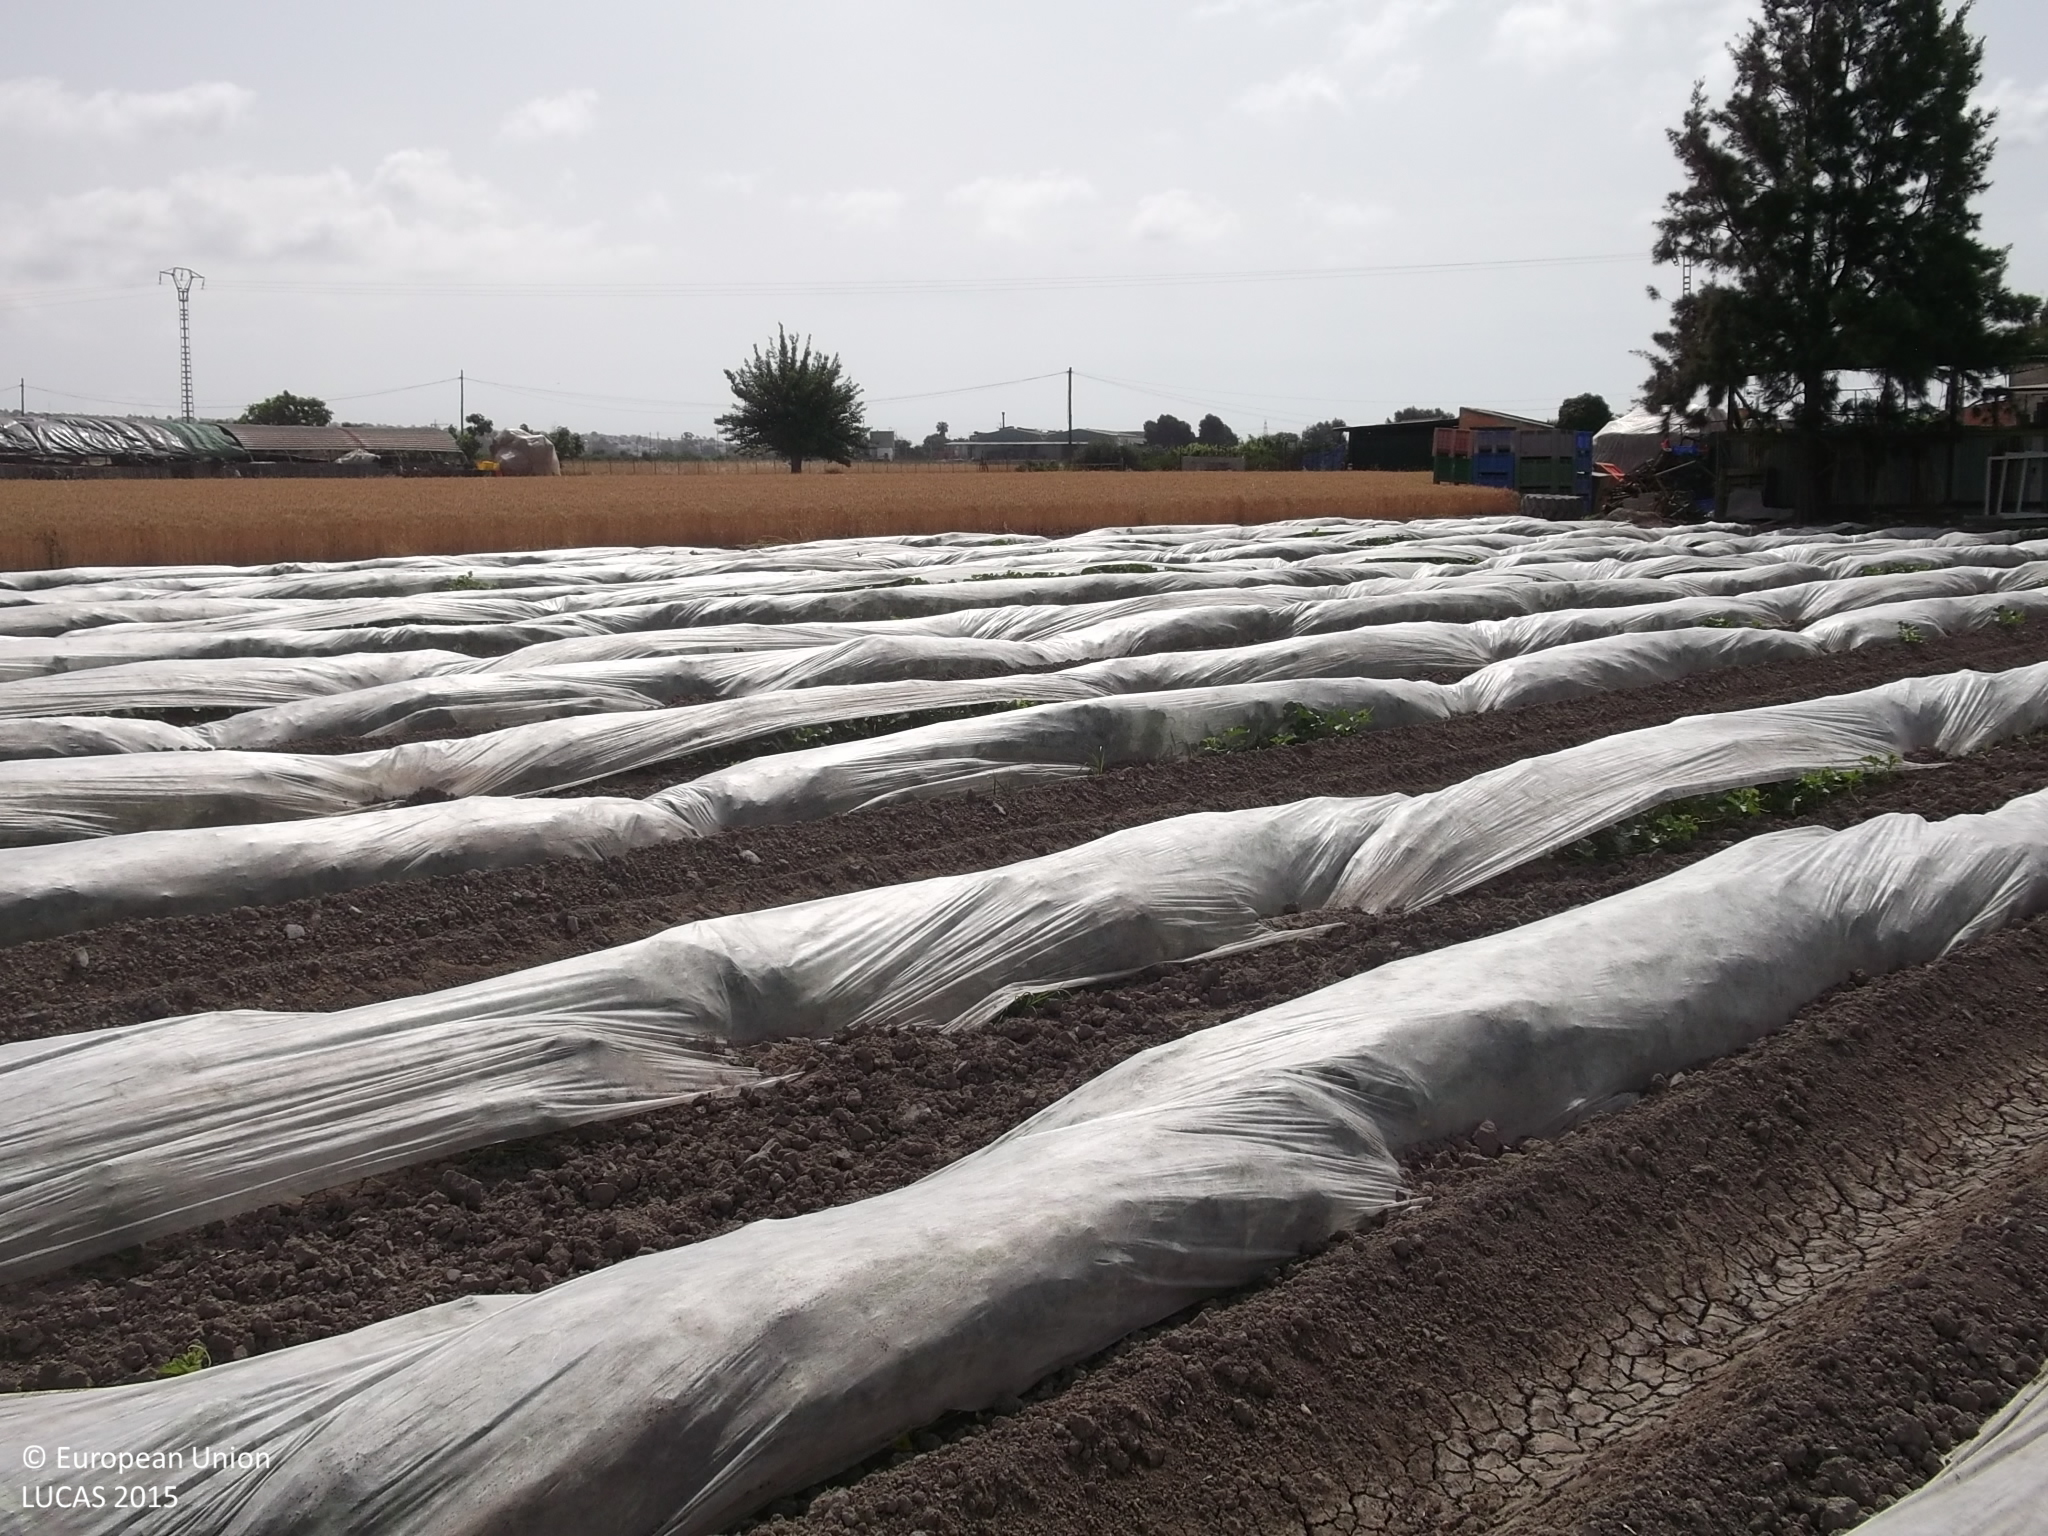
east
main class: Cropland
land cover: Other fresh vegetables
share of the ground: > 75 %
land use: Agriculture (excluding fallow land and kitchen gardens)
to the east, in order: Other fresh vegetables; Grass margins; Common wheat; Tracks; Other bare soil; Electric lines; Grass margins; Paved roads, cycling and walking lanes; Grass margins; Maize; Fences; Common wheat; Fences; Common wheat
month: May
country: ES
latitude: 38.1268
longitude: -0.7184
